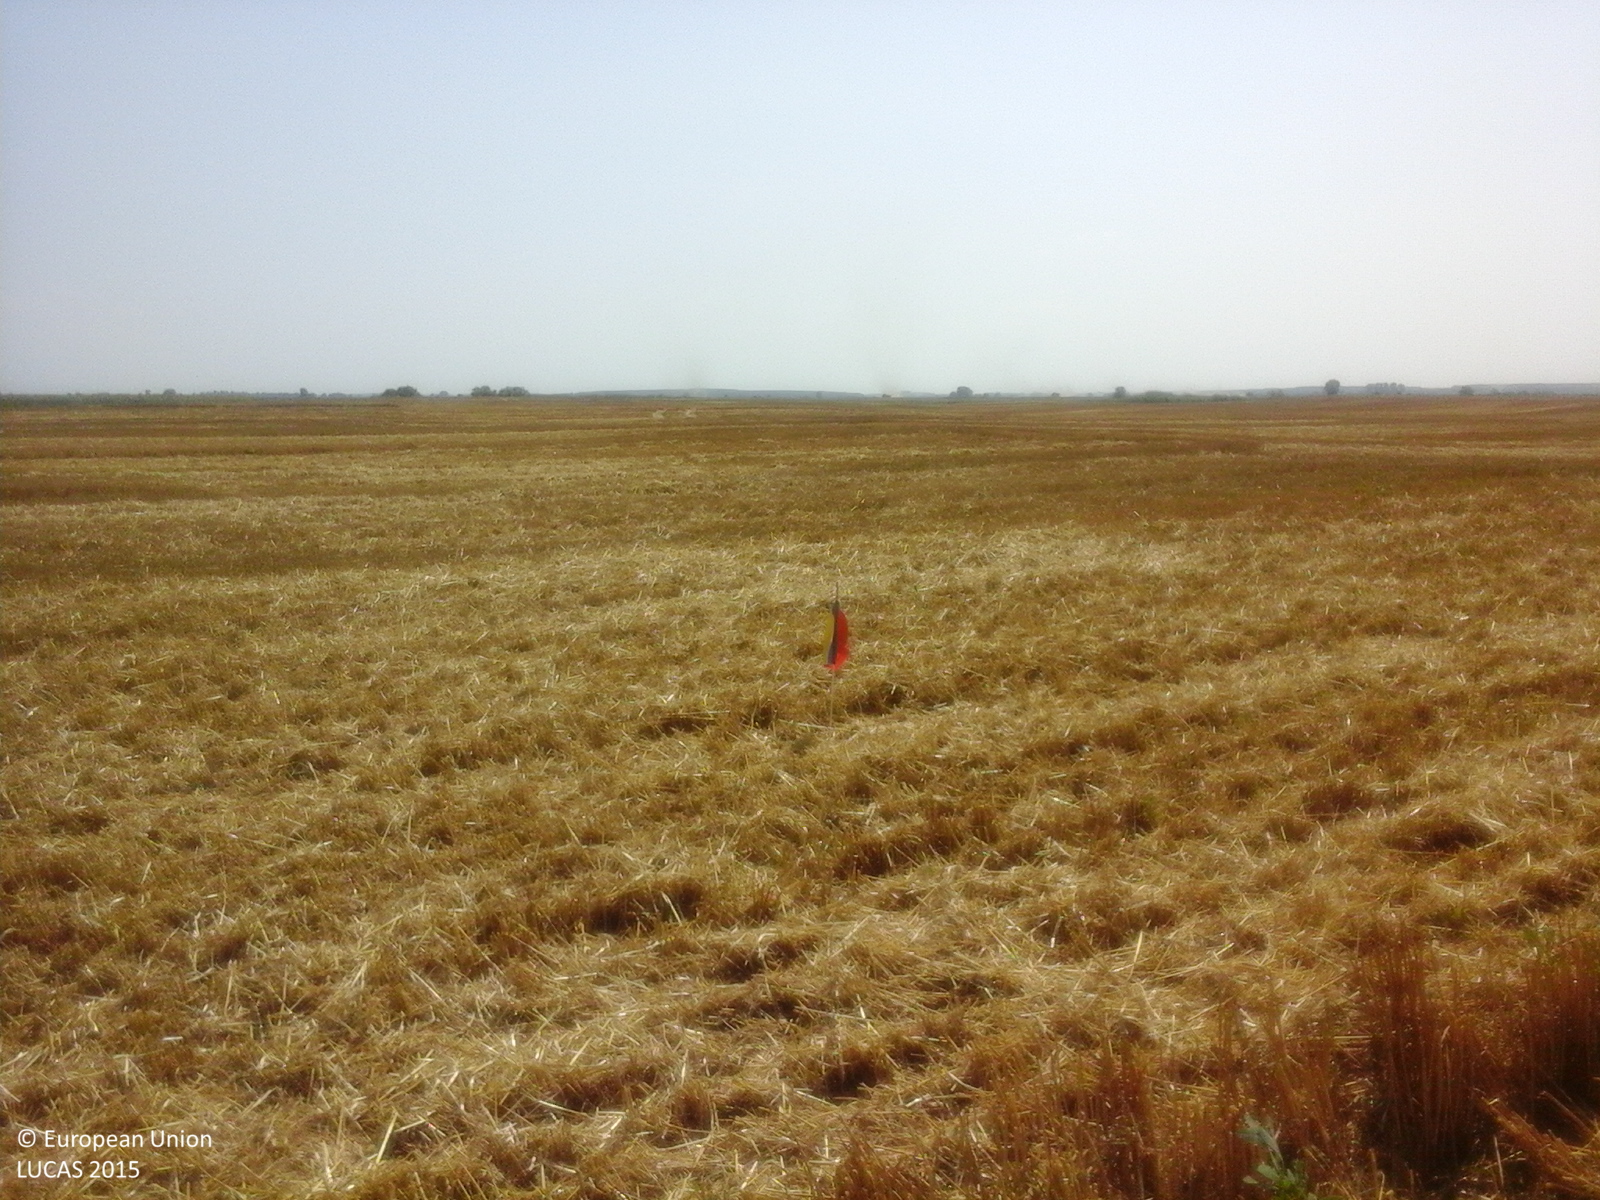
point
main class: Cropland
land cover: Common wheat
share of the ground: 50 - 75 %
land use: Agriculture (excluding fallow land and kitchen gardens)
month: July
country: RO
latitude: 44.6070
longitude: 27.9878
